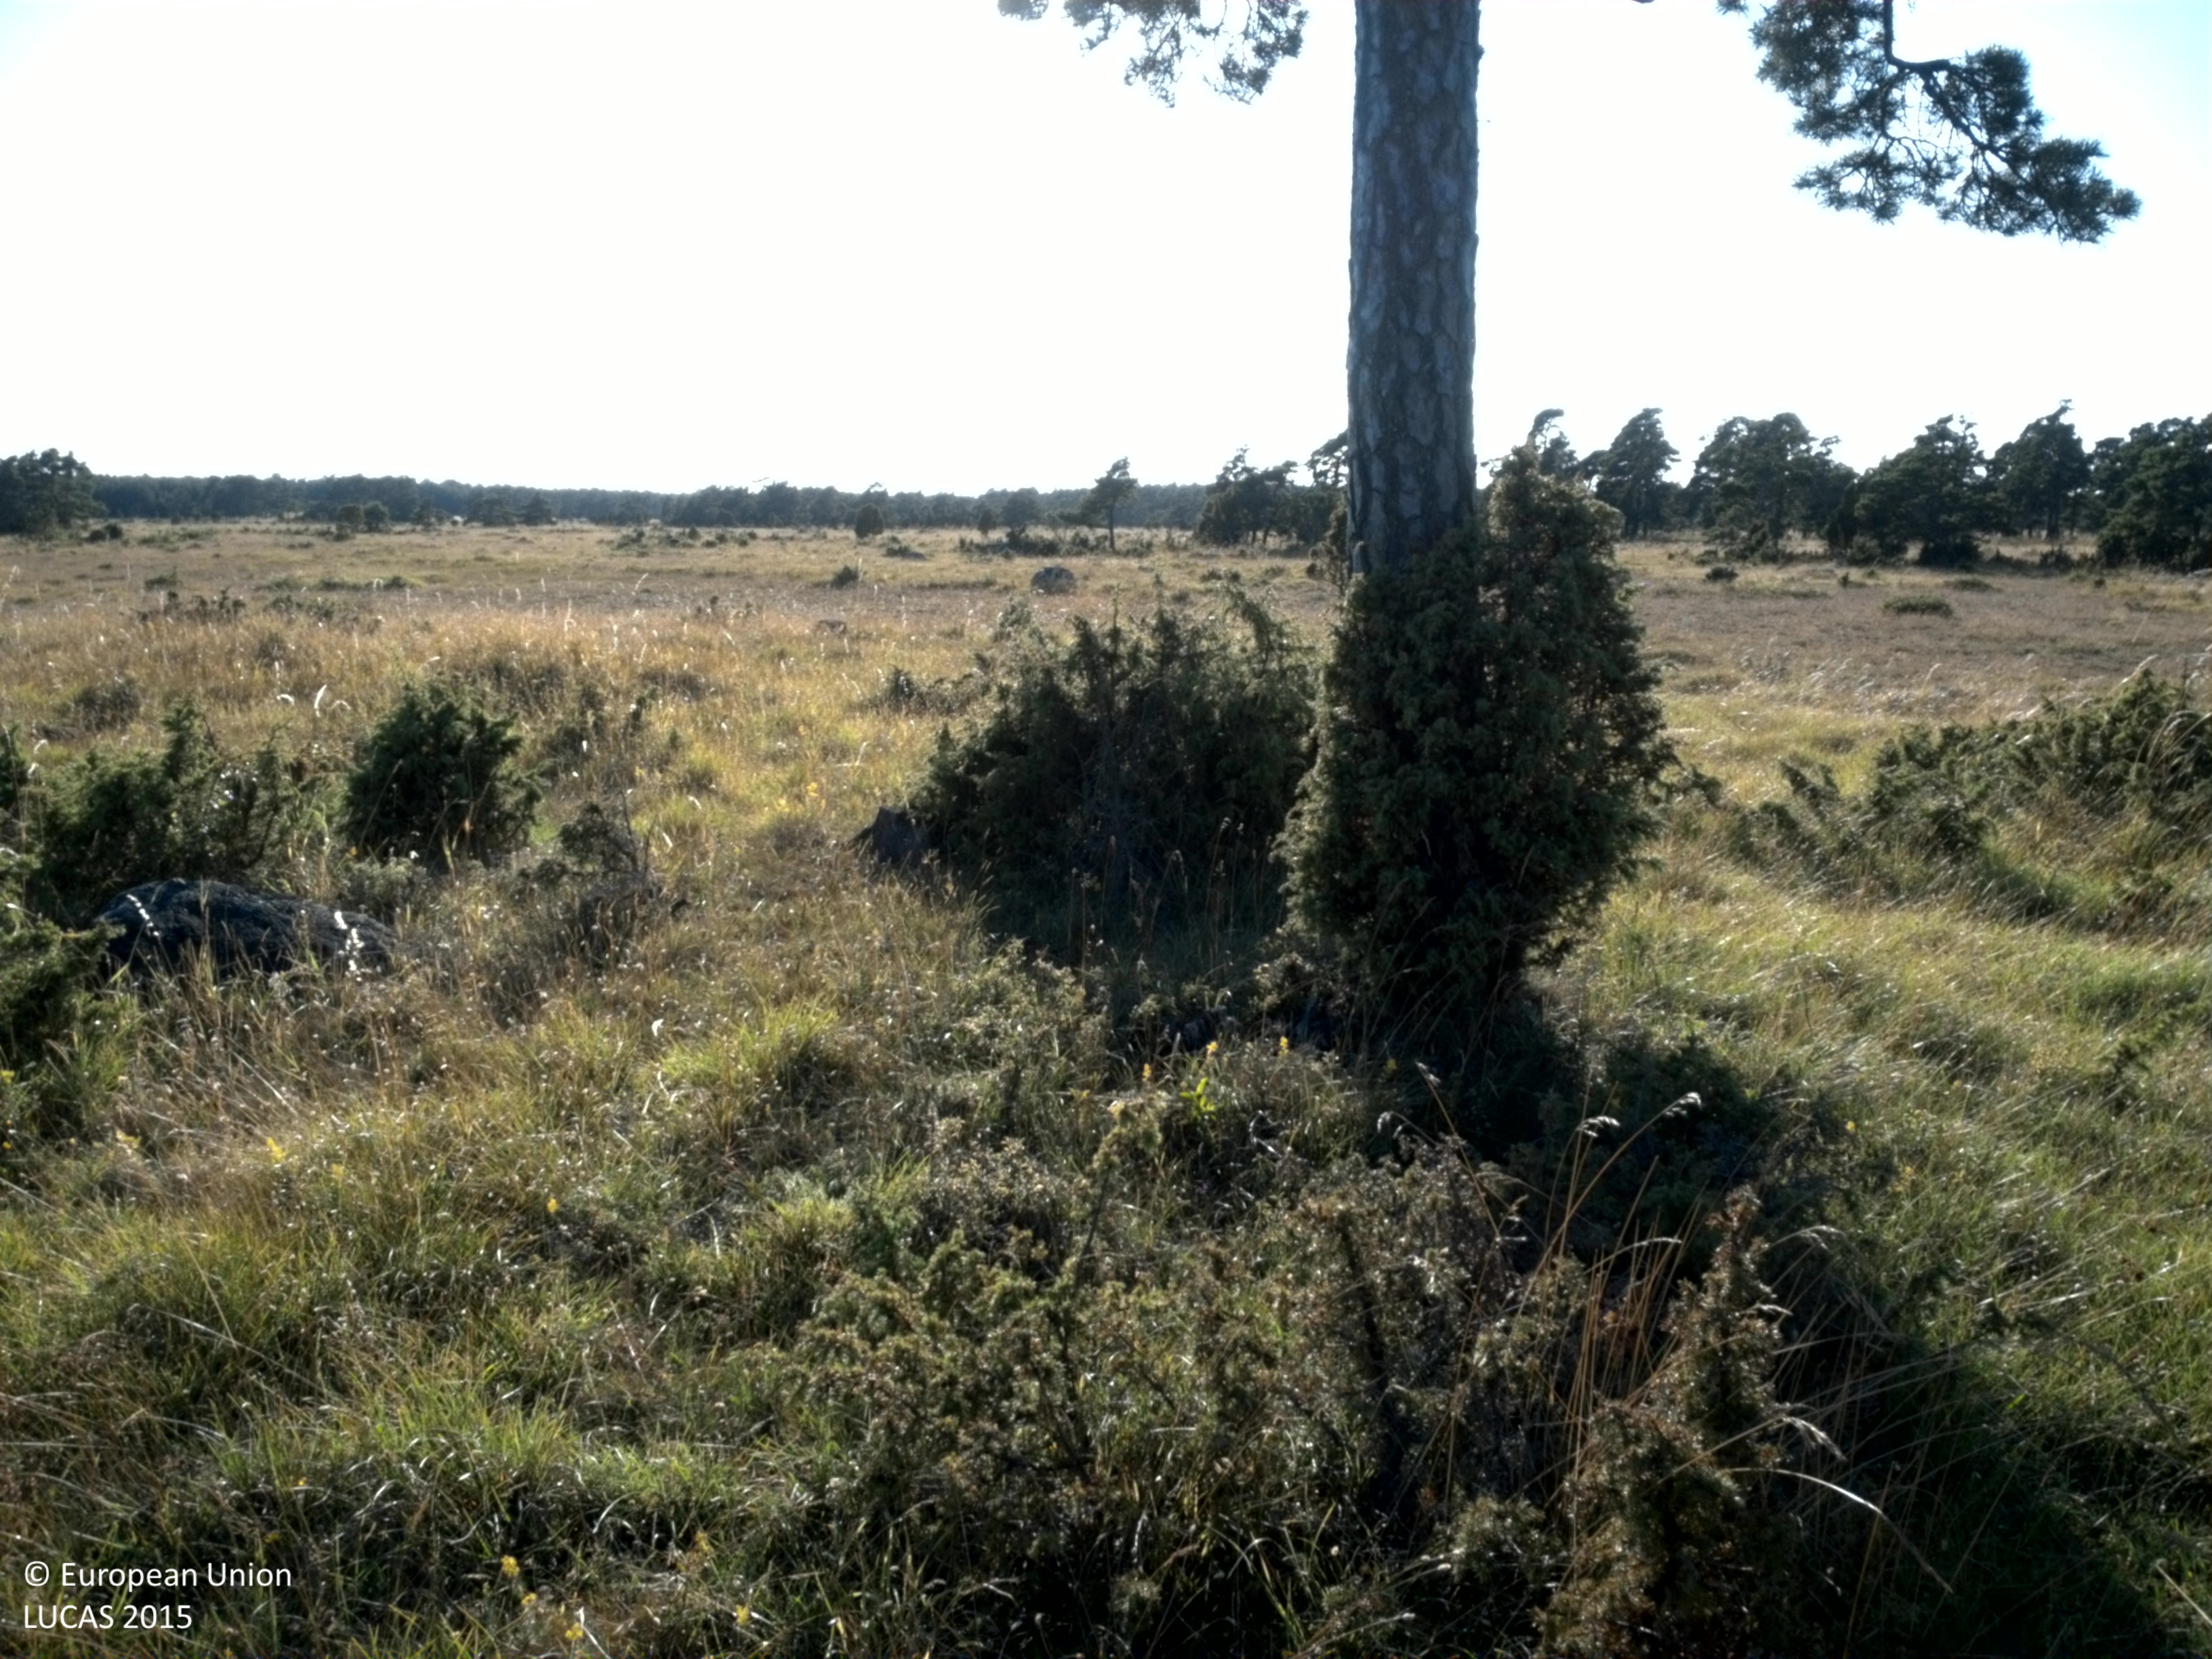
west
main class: Grassland
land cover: Grassland with sparse tree/shrub cover
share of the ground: > 75 %
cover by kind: herbaceous plants 90 %, coniferous forest trees 5 %, shrubs 5 %
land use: Agriculture (excluding fallow land and kitchen gardens)
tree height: > 5 m
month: July
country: SE
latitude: 57.1586
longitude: 18.4247
